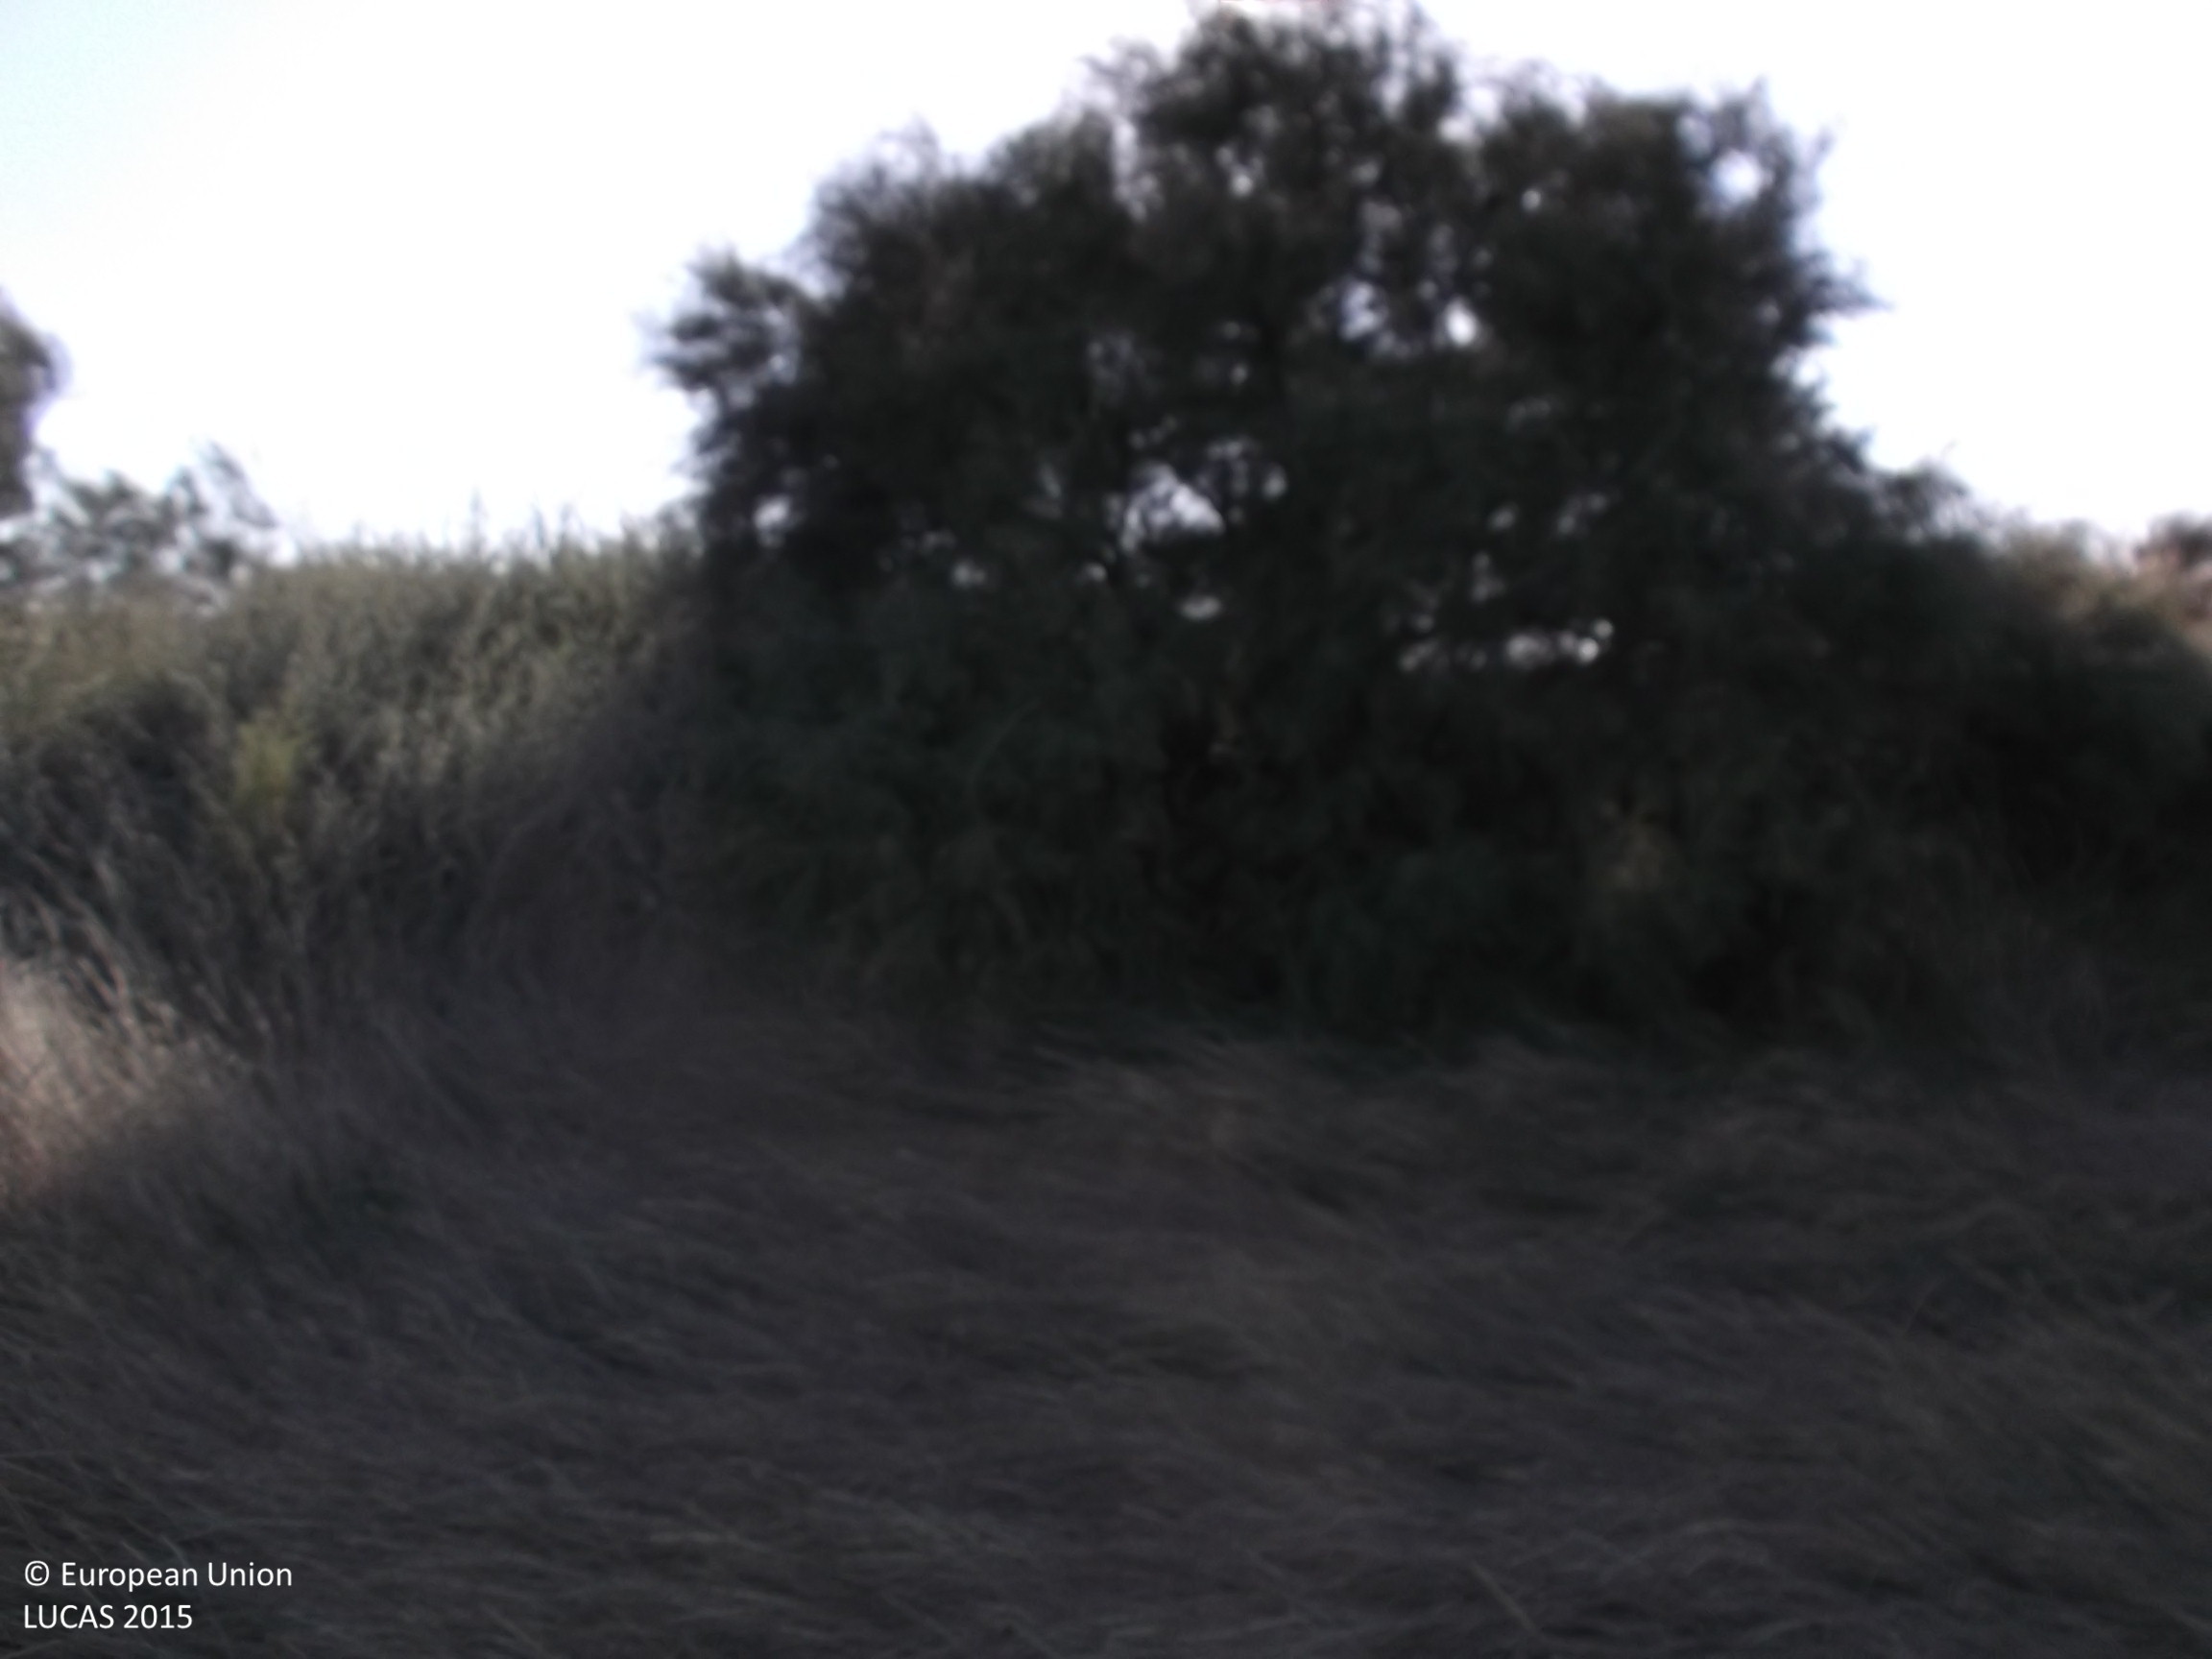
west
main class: Grassland
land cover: Grassland without tree/shrub cover
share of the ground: > 75 %
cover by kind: herbaceous plants 95 %
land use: Semi-natural and natural areas not in use
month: July
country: ES
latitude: 42.3109
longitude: -1.6204
